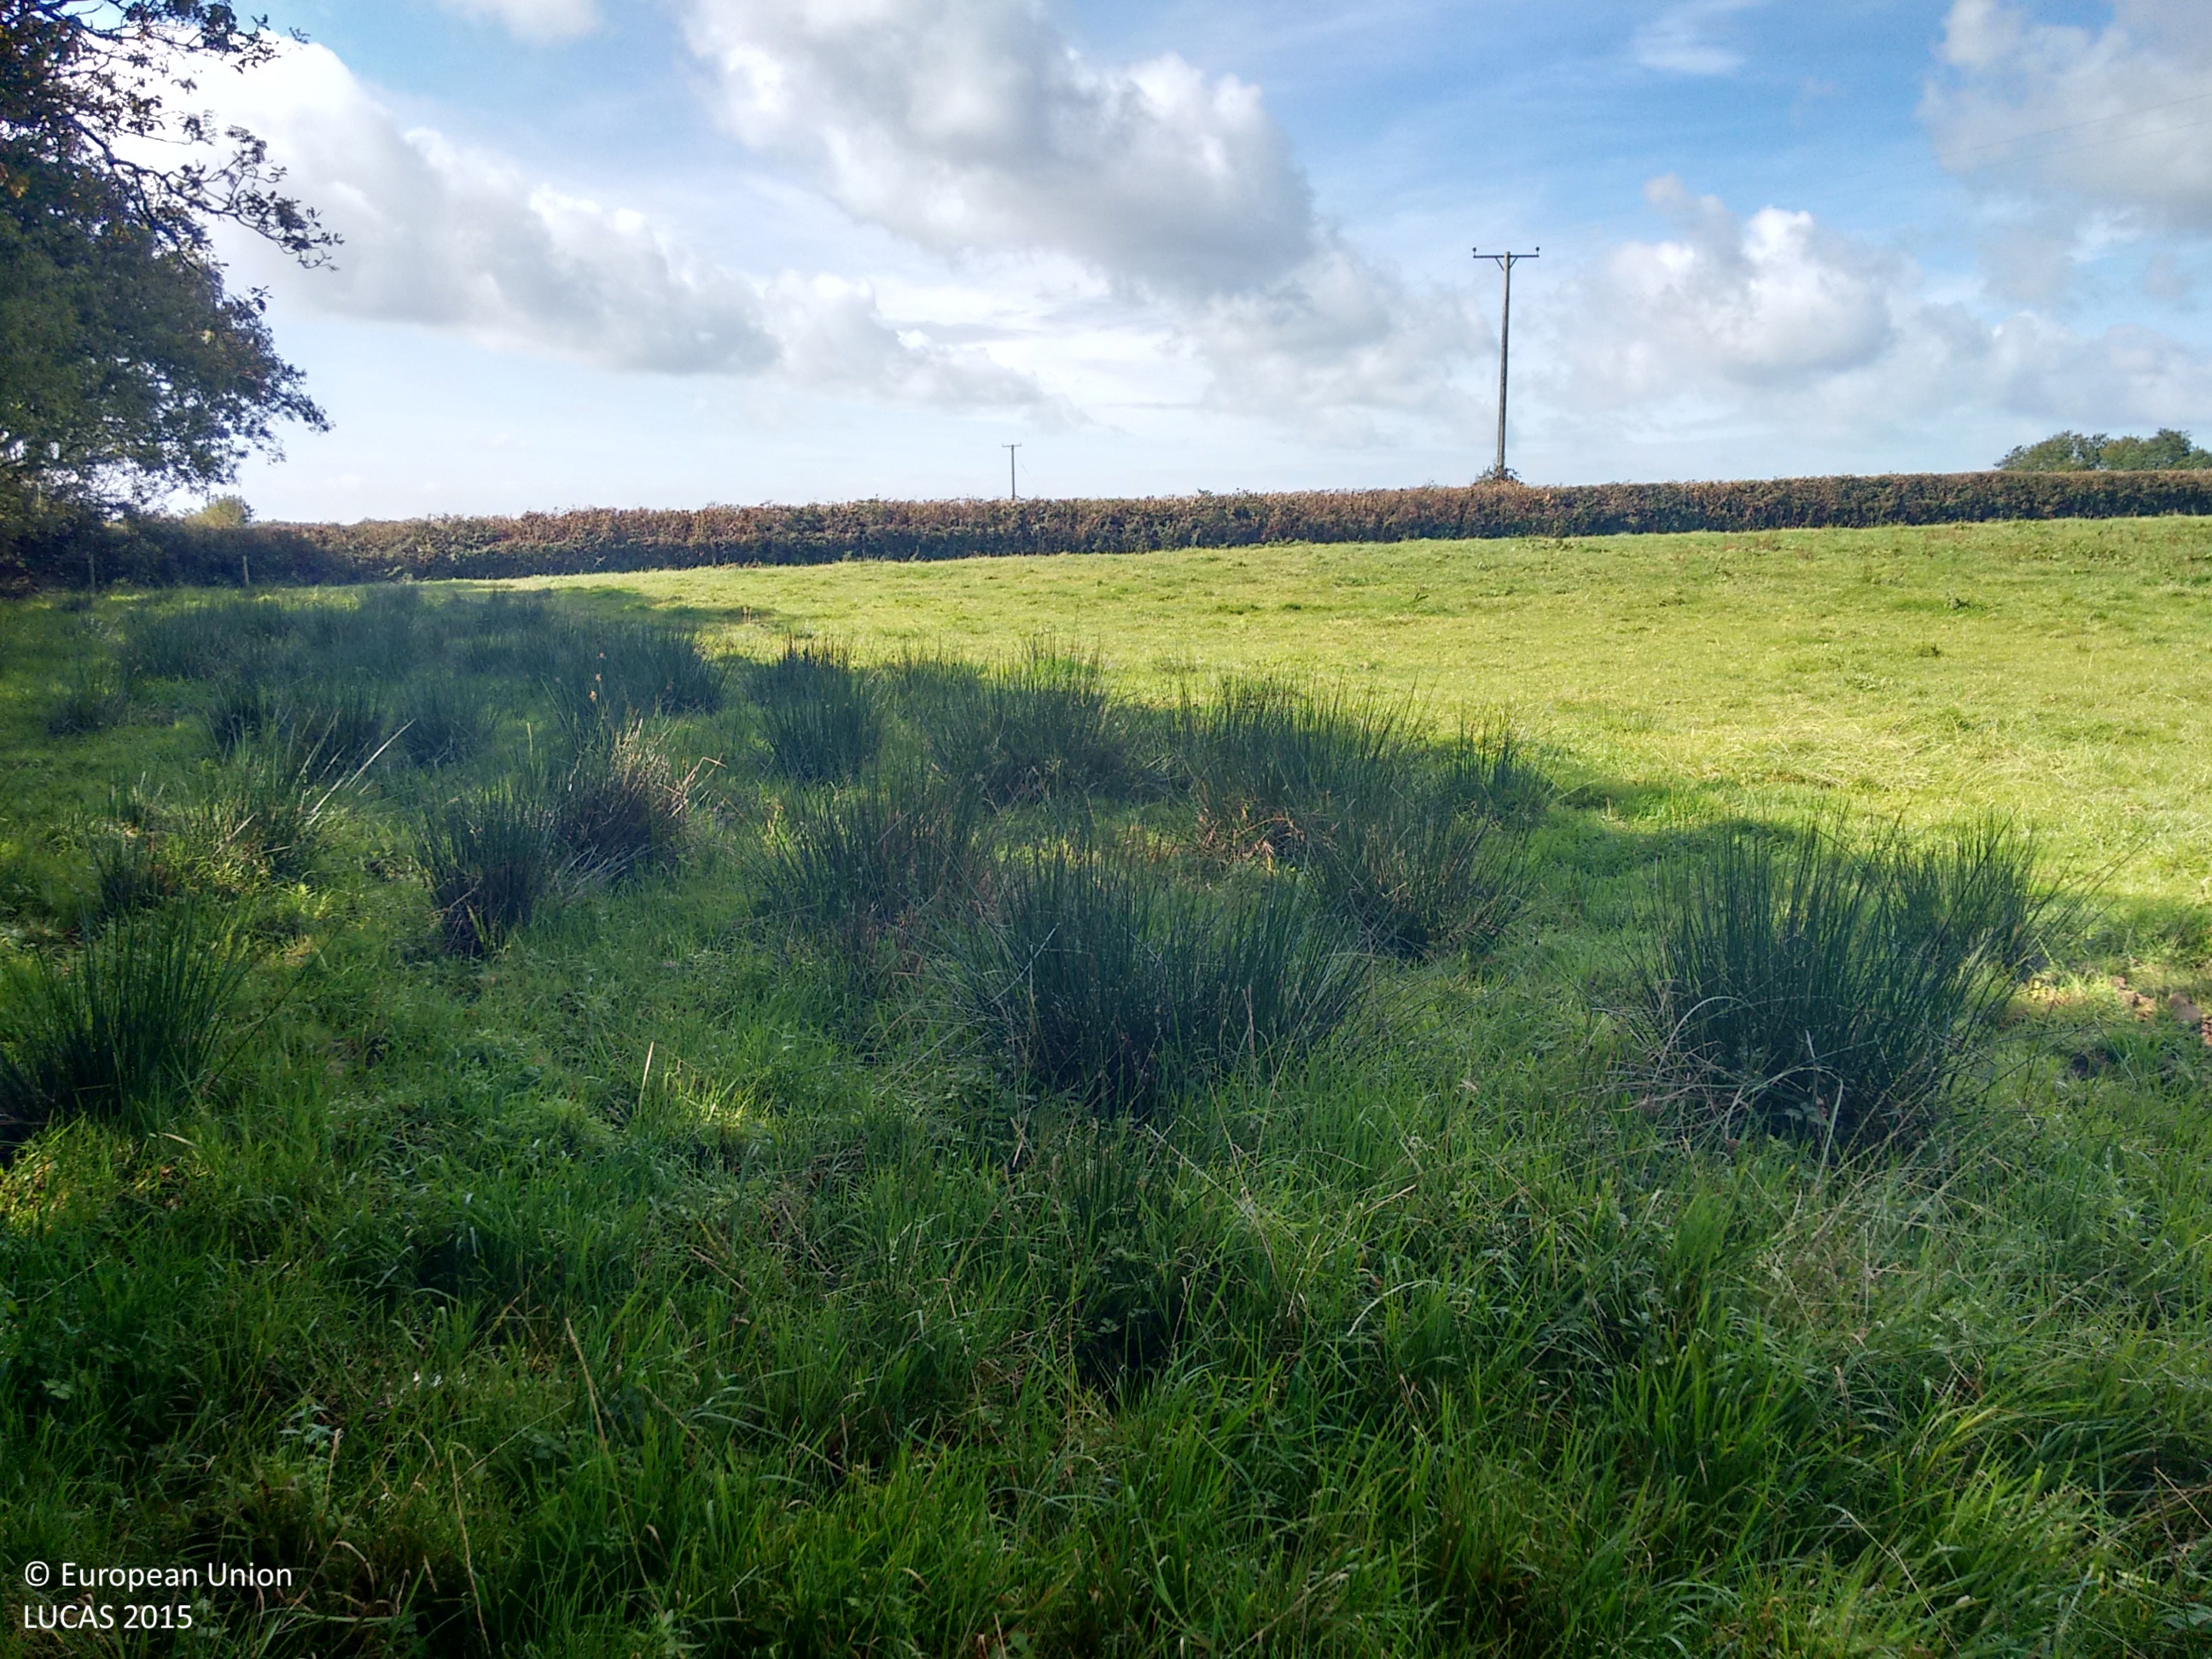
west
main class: Grassland
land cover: Grassland without tree/shrub cover
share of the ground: > 75 %
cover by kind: herbaceous plants 100 %
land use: Agriculture (excluding fallow land and kitchen gardens)
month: September
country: GB
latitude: 50.7682
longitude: -4.2064
